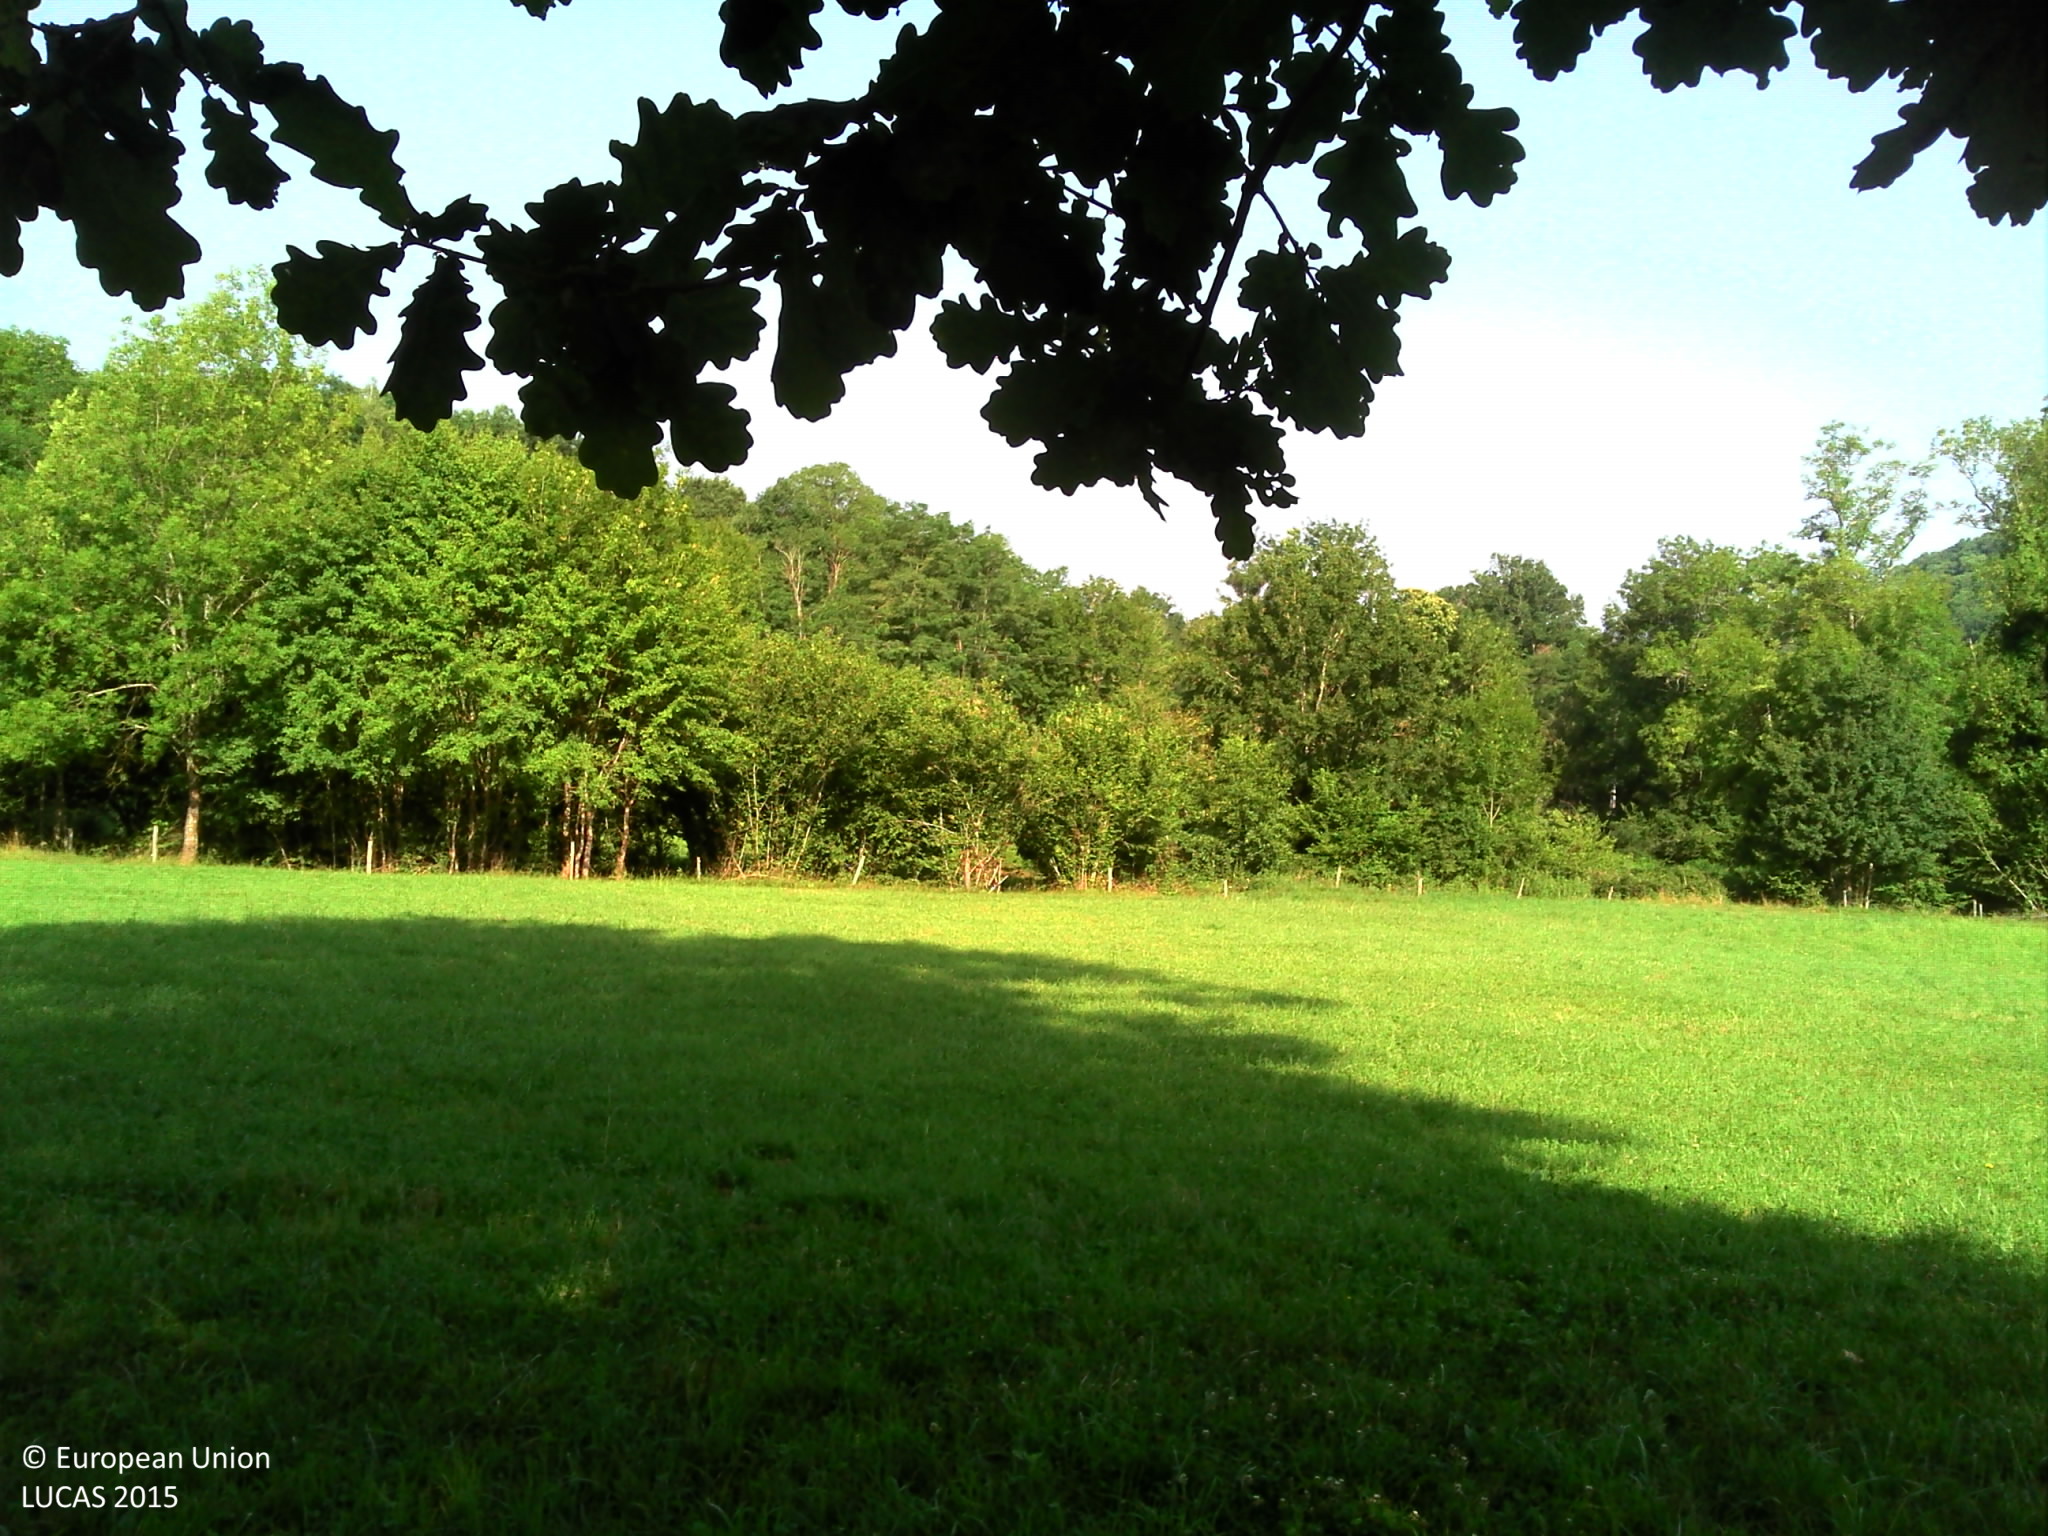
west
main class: Grassland
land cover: Grassland without tree/shrub cover
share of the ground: > 75 %
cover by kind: herbaceous plants 100 %
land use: Agriculture (excluding fallow land and kitchen gardens)
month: July
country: FR
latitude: 43.0806
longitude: 1.1236
